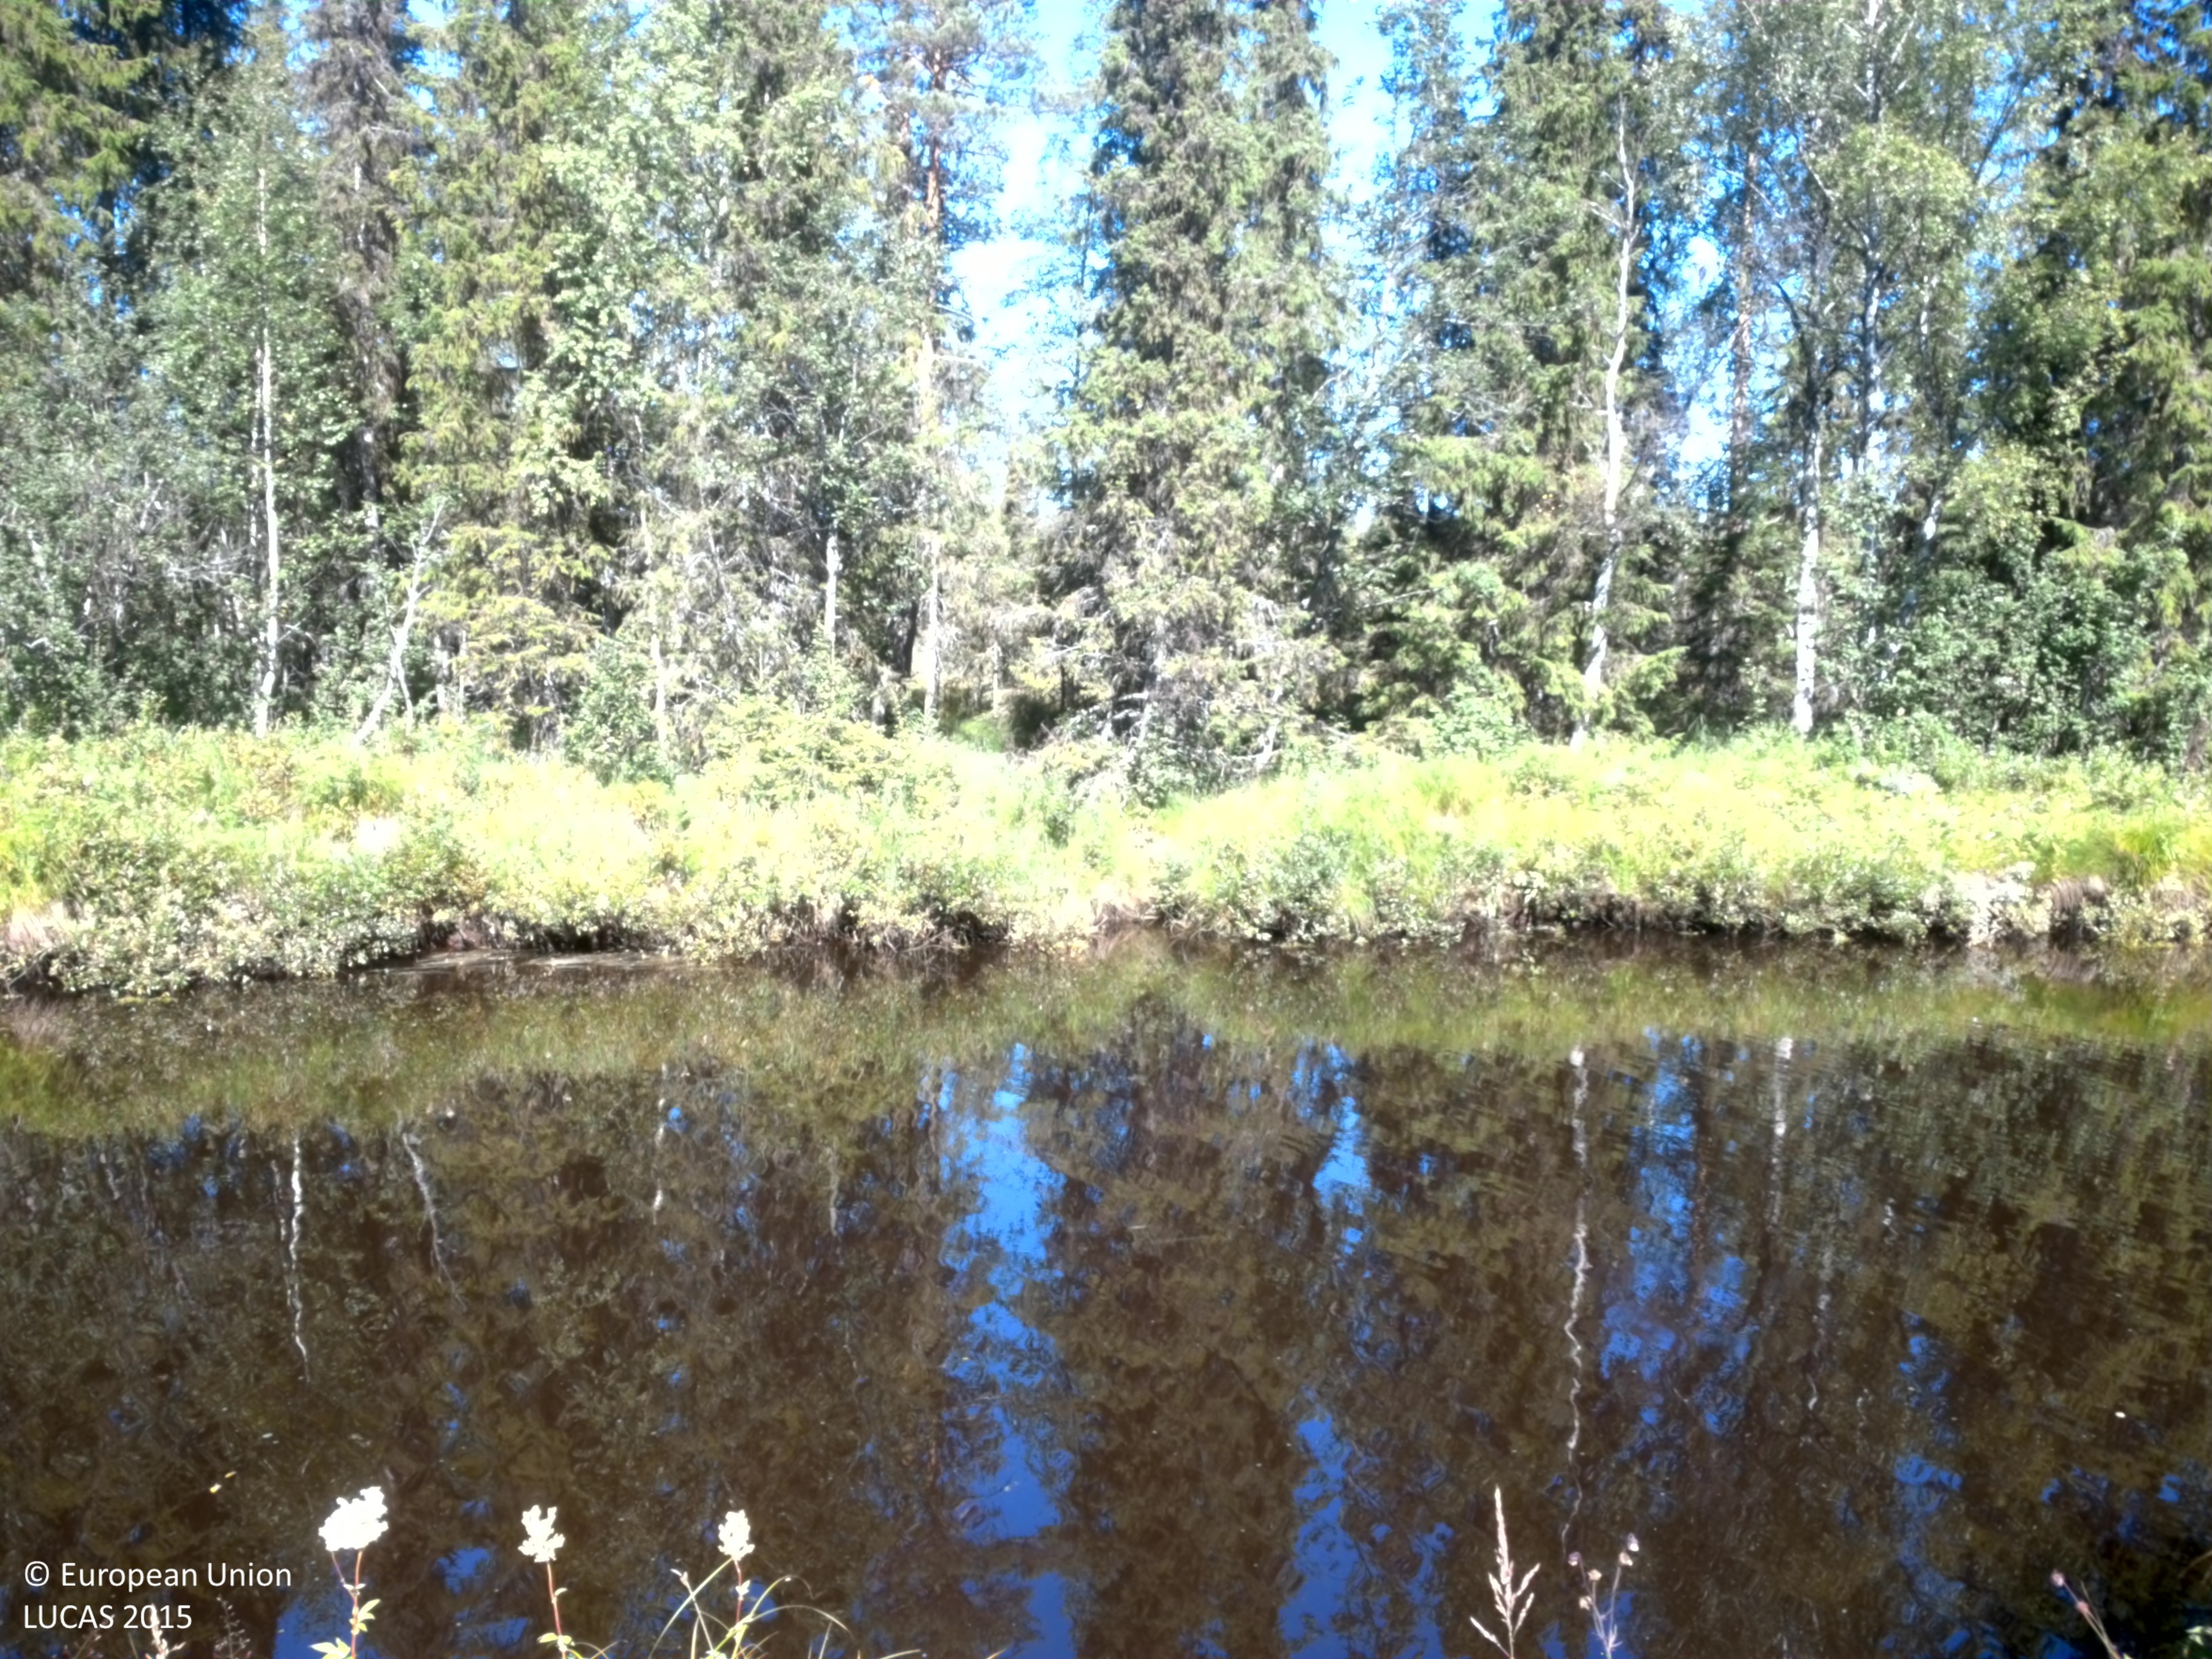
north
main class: Grassland
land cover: Grassland with sparse tree/shrub cover
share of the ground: > 75 %
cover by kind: herbaceous plants 95 %, broadleaved forest trees 5 %
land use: Semi-natural and natural areas not in use
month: August
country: SE
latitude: 64.3262
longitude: 18.6380
